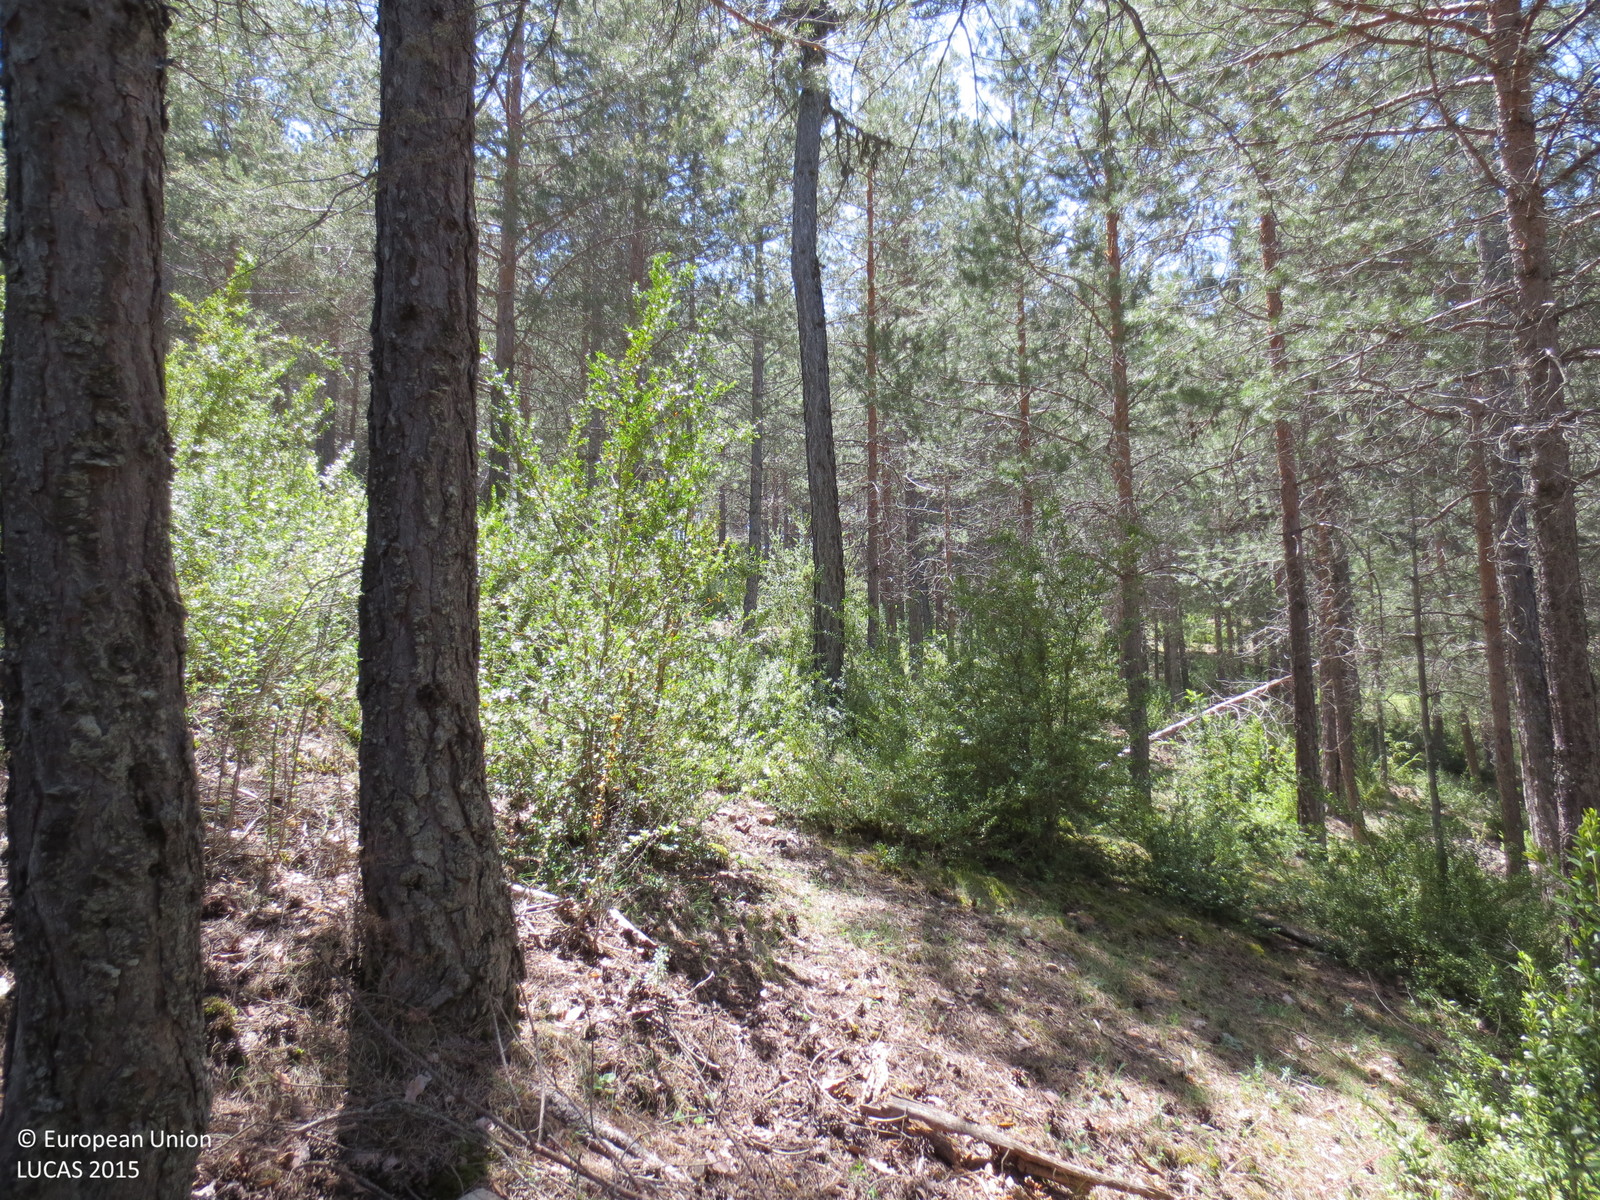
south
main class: Woodland
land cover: Pine dominated coniferous woodland
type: coniferous forest of the mediterranean region
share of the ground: 50 - 75 %
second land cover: Shrubland without tree cover
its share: 25 - 50 %
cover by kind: coniferous forest trees 60 %, shrubs 30 %, herbaceous plants 10 %
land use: Forestry
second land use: Agriculture (excluding fallow land and kitchen gardens)
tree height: > 5 m
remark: Clear cut
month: May
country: ES
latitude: 40.3717
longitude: -1.9718
